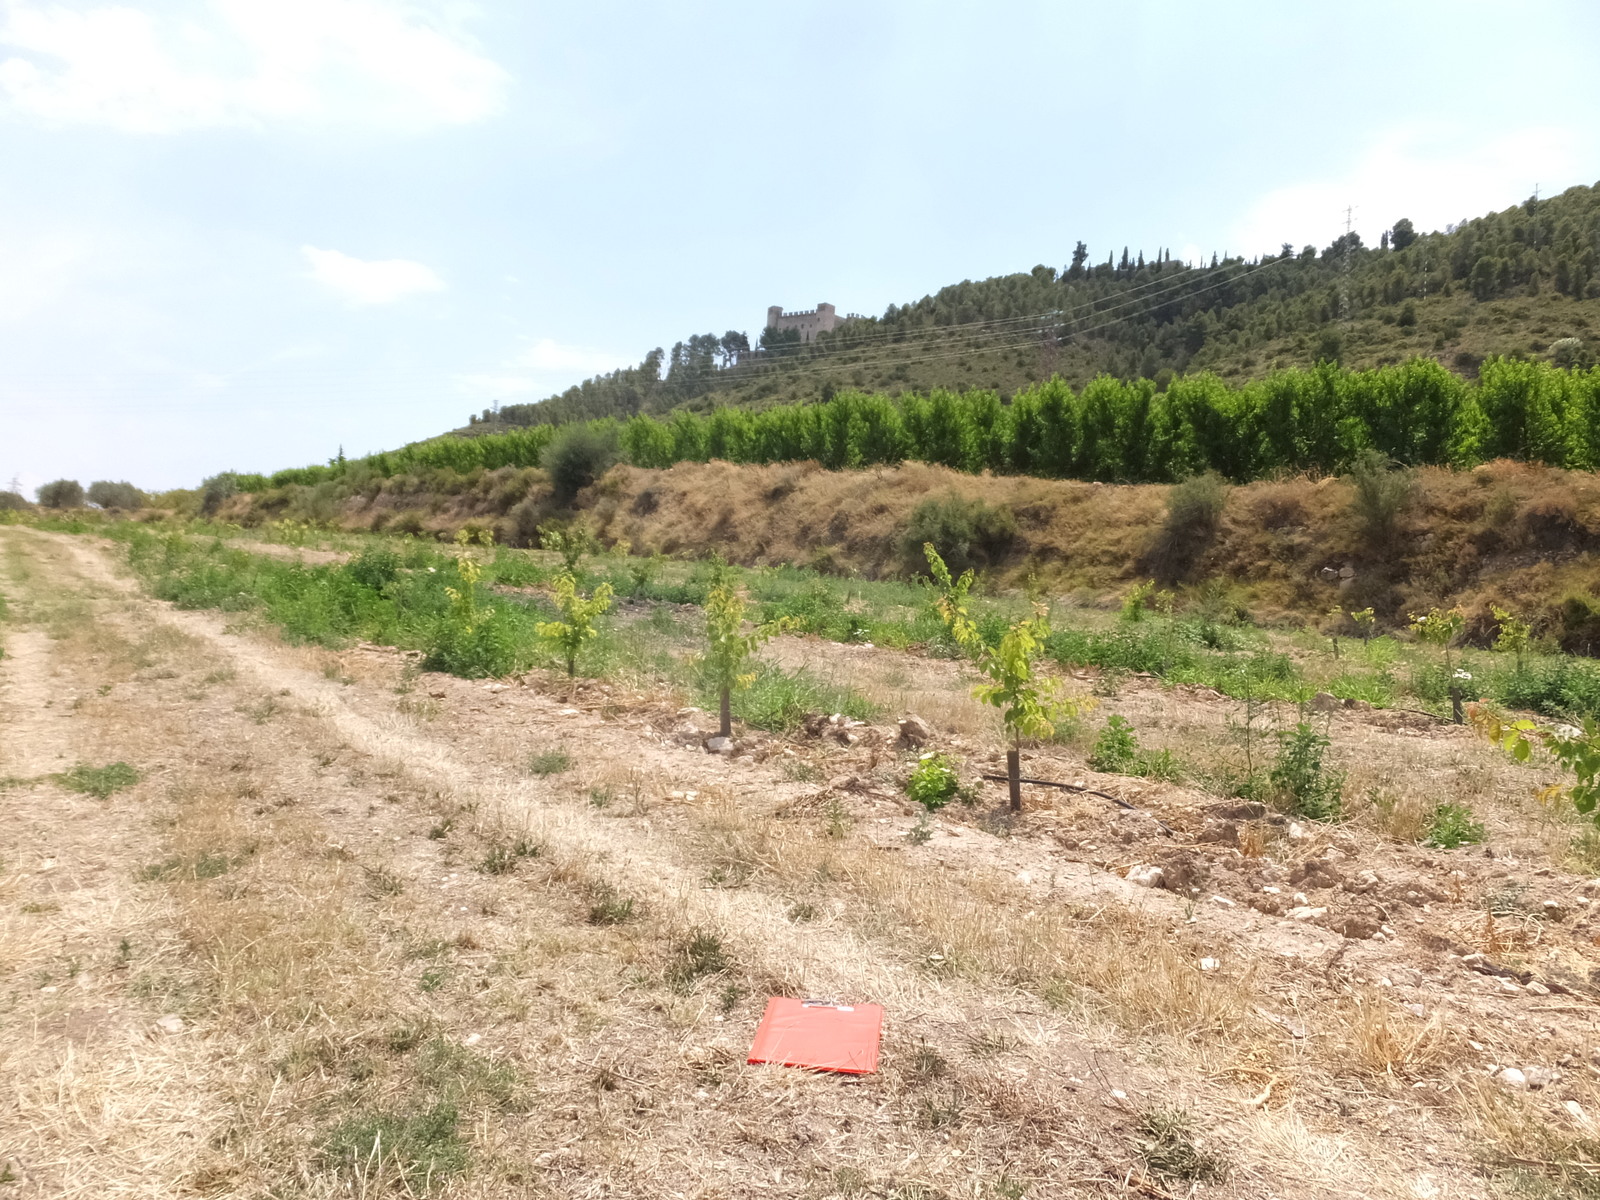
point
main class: Cropland
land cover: Other fruit trees and berries
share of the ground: 10 - 25 %
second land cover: Spontaneously vegetated surfaces
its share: 50 - 75 %
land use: Agriculture (excluding fallow land and kitchen gardens)
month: June
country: ES
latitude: 41.3684
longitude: 0.2923
